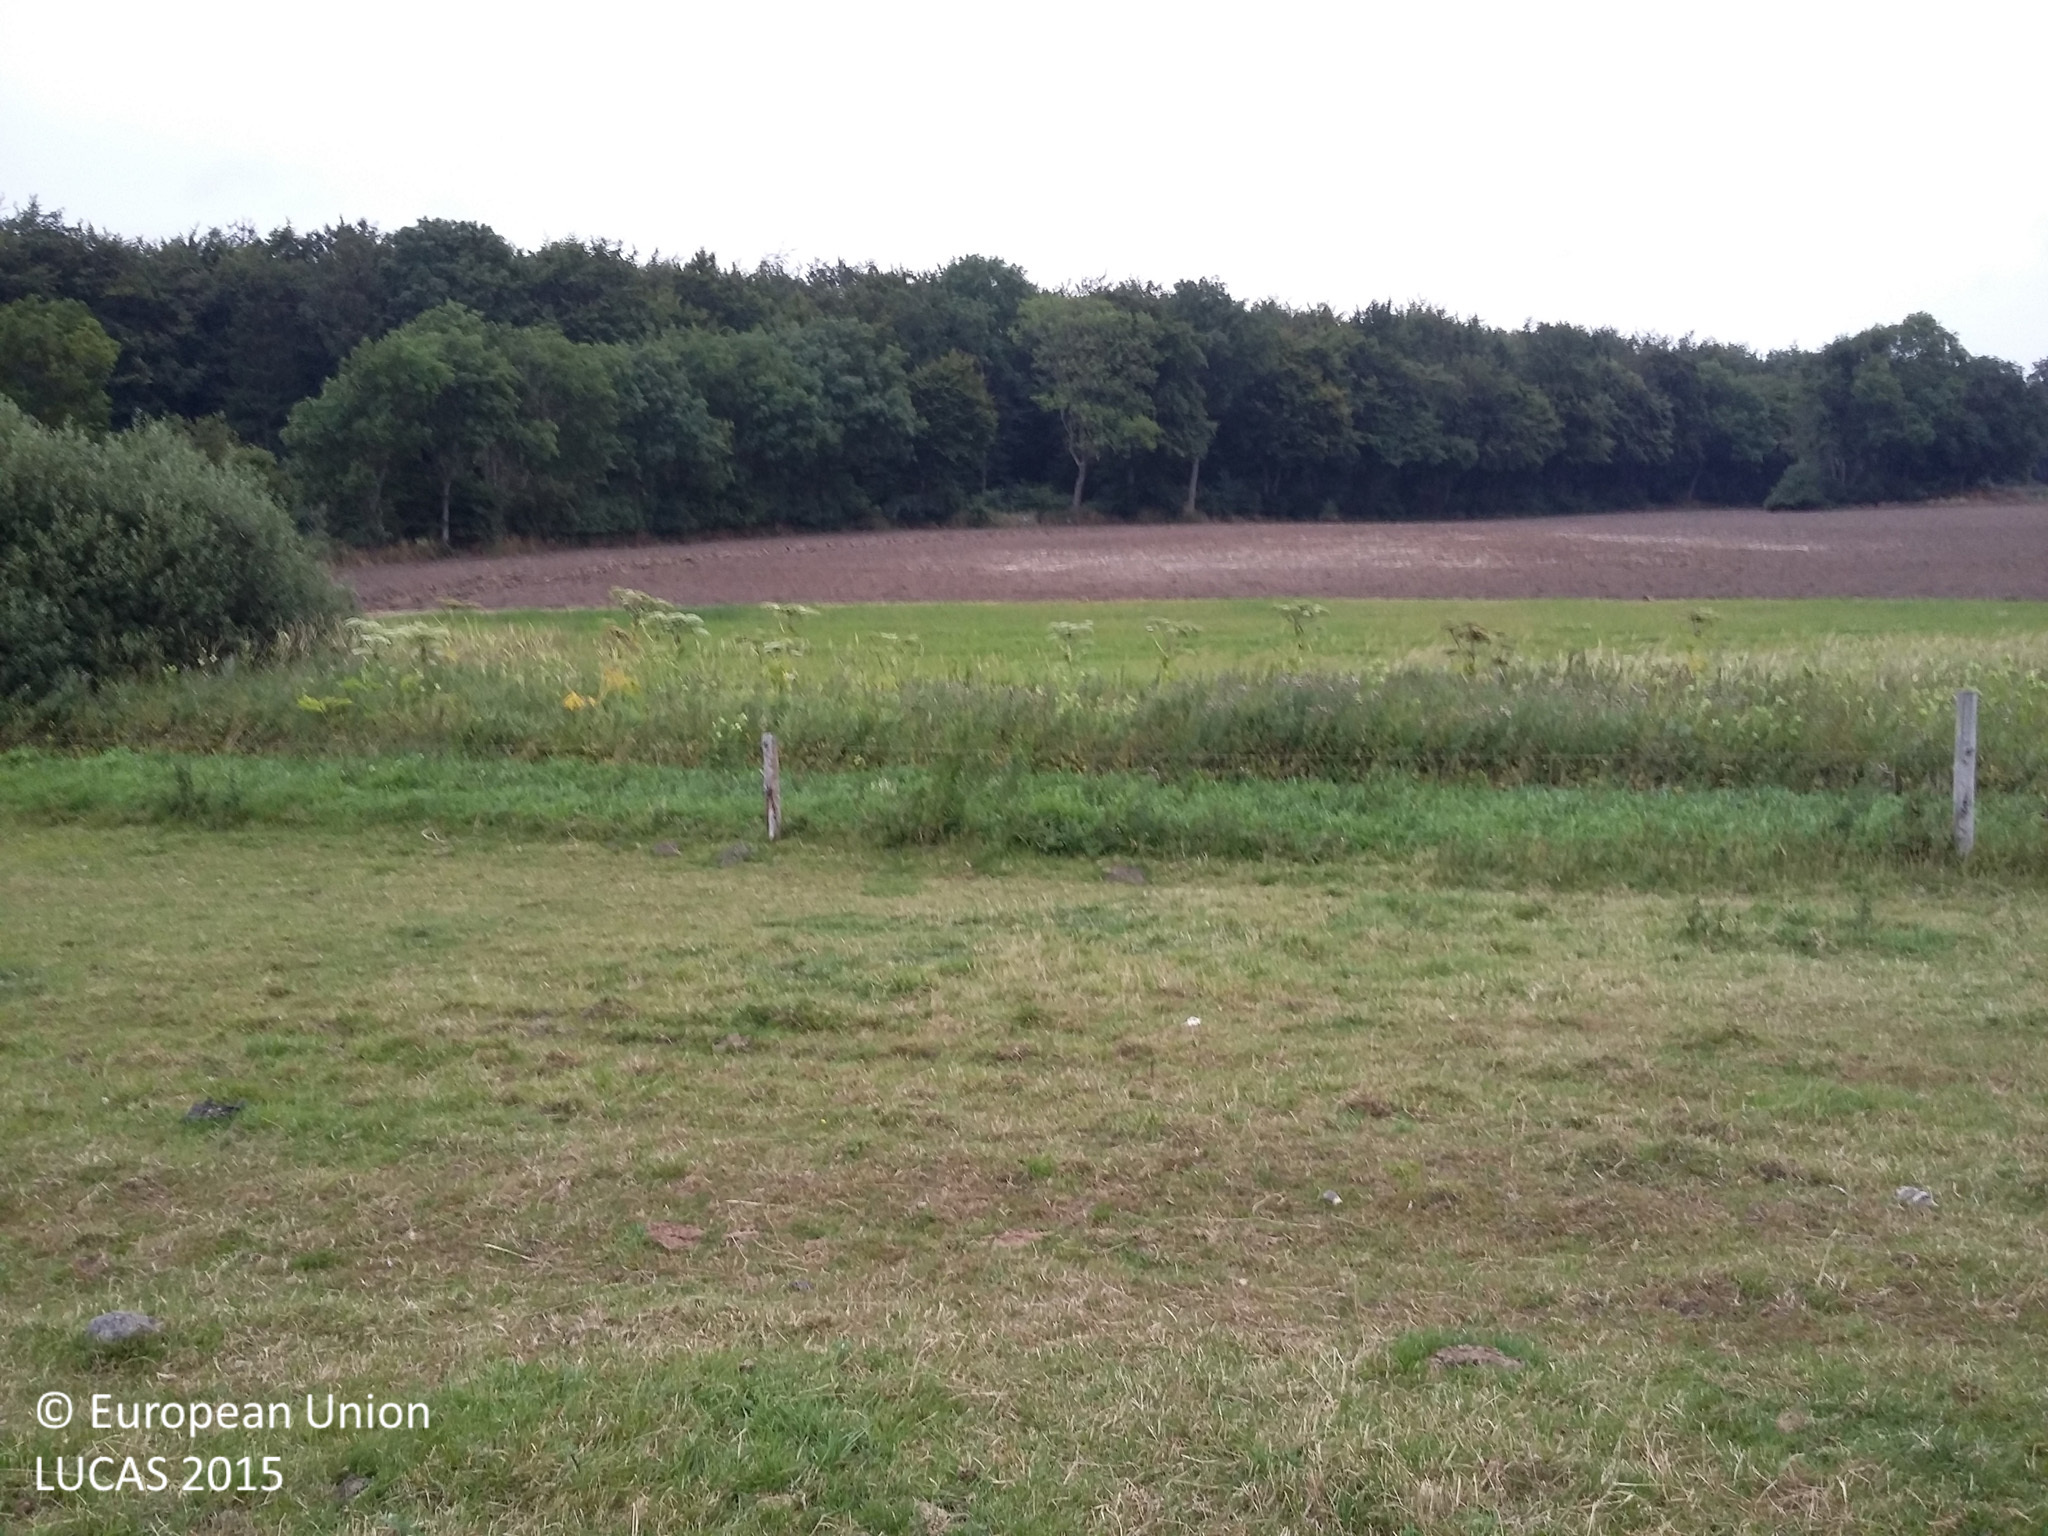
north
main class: Grassland
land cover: Grassland without tree/shrub cover
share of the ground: > 75 %
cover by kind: herbaceous plants 100 %
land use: Agriculture (excluding fallow land and kitchen gardens)
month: August
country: DK
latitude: 55.4938
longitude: 11.6605
